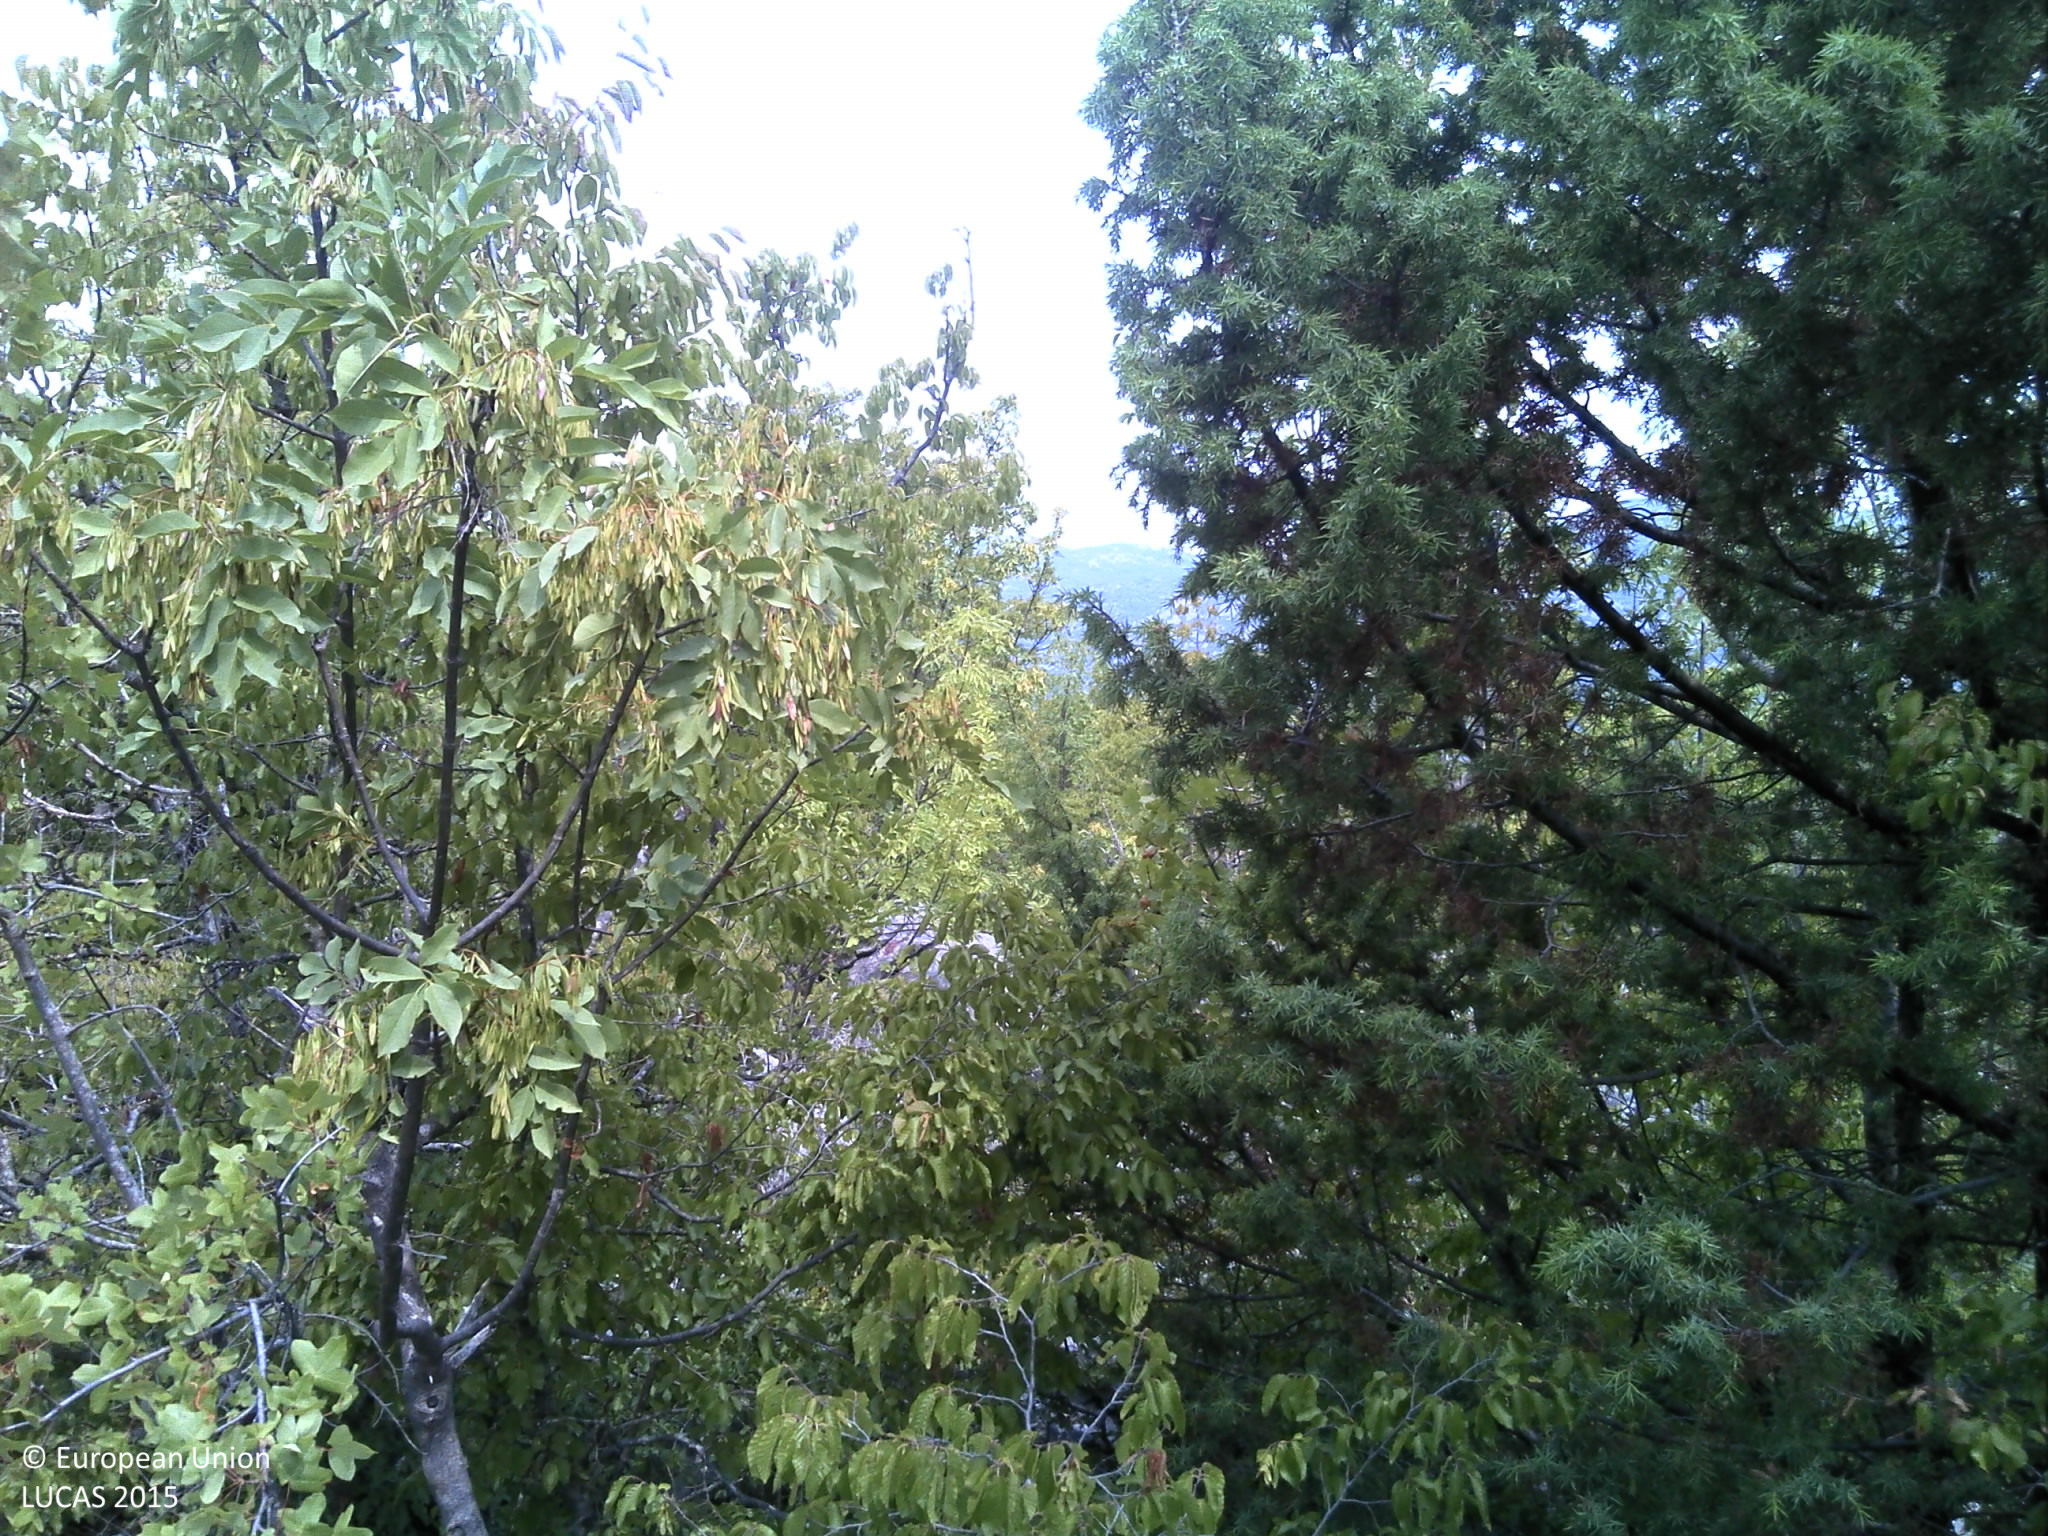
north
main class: Shrubland
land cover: Shrubland with sparse tree cover
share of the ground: 50 - 75 %
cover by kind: shrubs 70 %, consolidated bare surface 10 %, unconsolidated bare surface 10 %, broadleaved forest trees 5 %, herbaceous plants 5 %
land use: Semi-natural and natural areas not in use
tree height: < 5 m
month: August
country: HR
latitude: 43.3068
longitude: 17.1538
